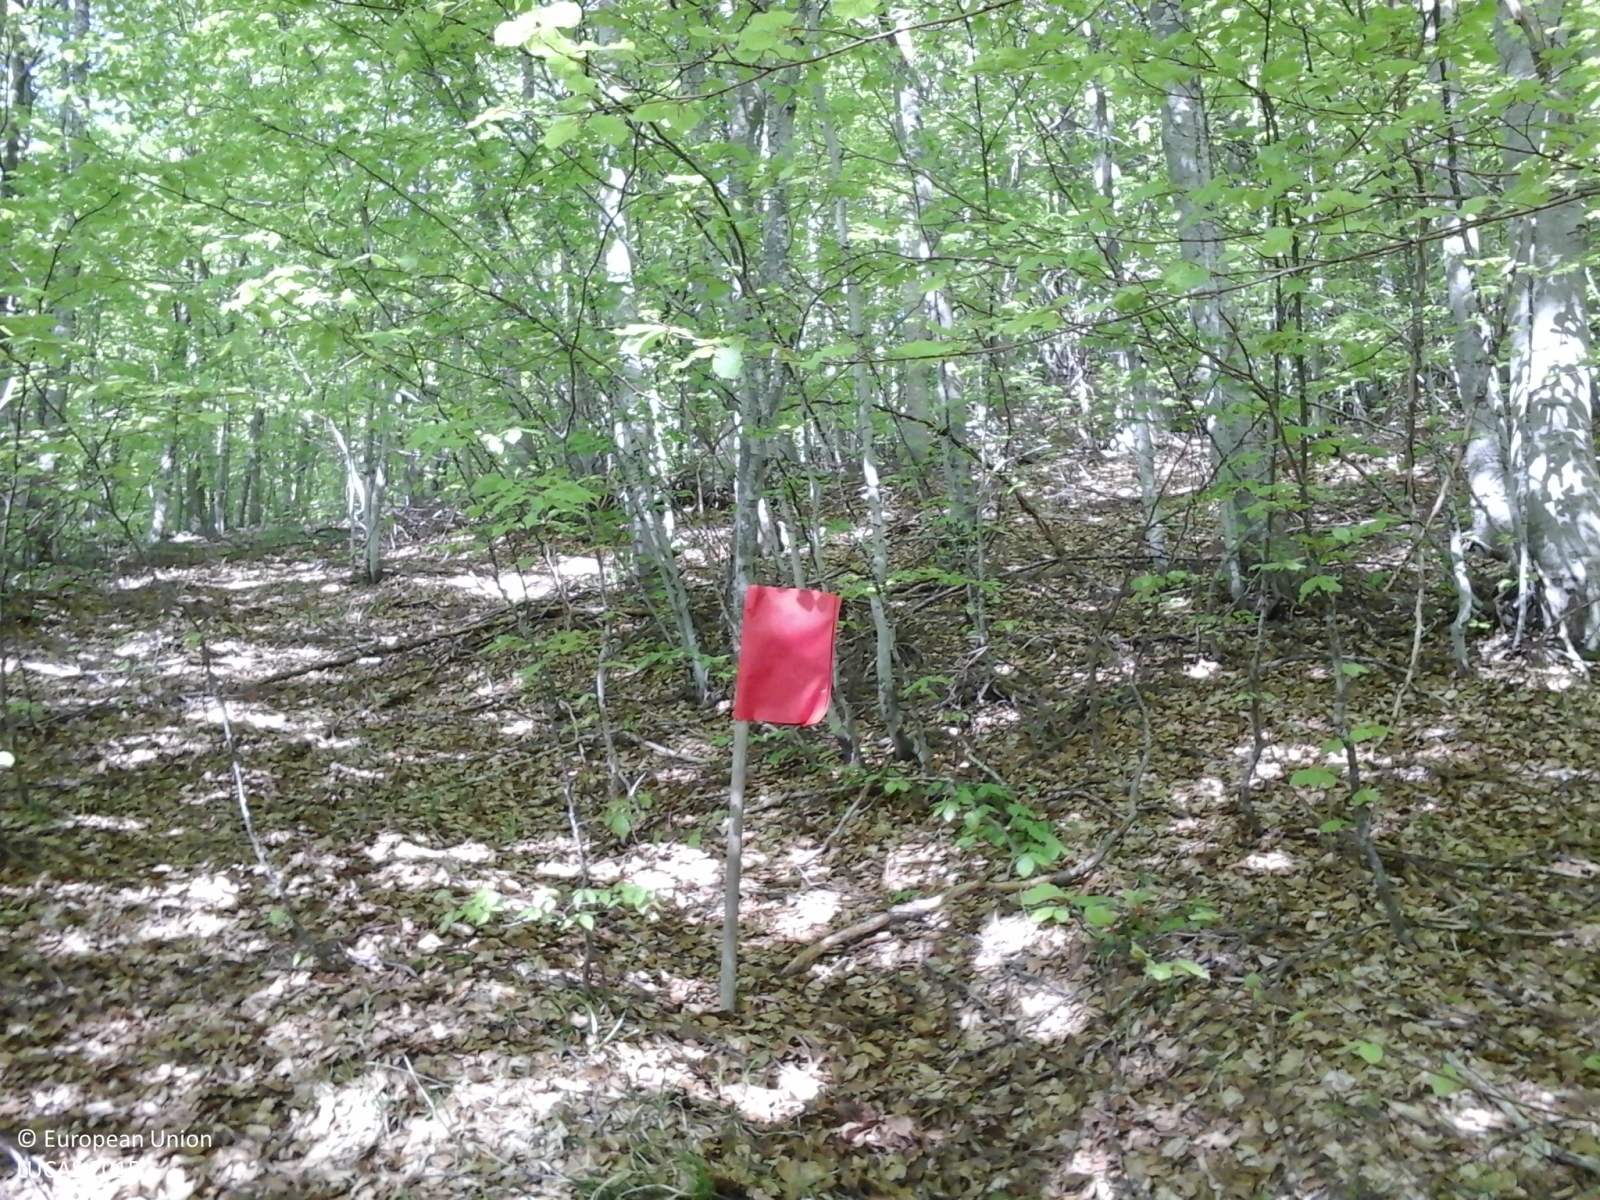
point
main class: Woodland
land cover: Broadleaved woodland
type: mountainous beech forest
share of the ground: > 75 %
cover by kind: broadleaved forest trees 100 %
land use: Forestry
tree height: > 5 m
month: May
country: IT
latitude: 44.6722
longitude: 9.2070
